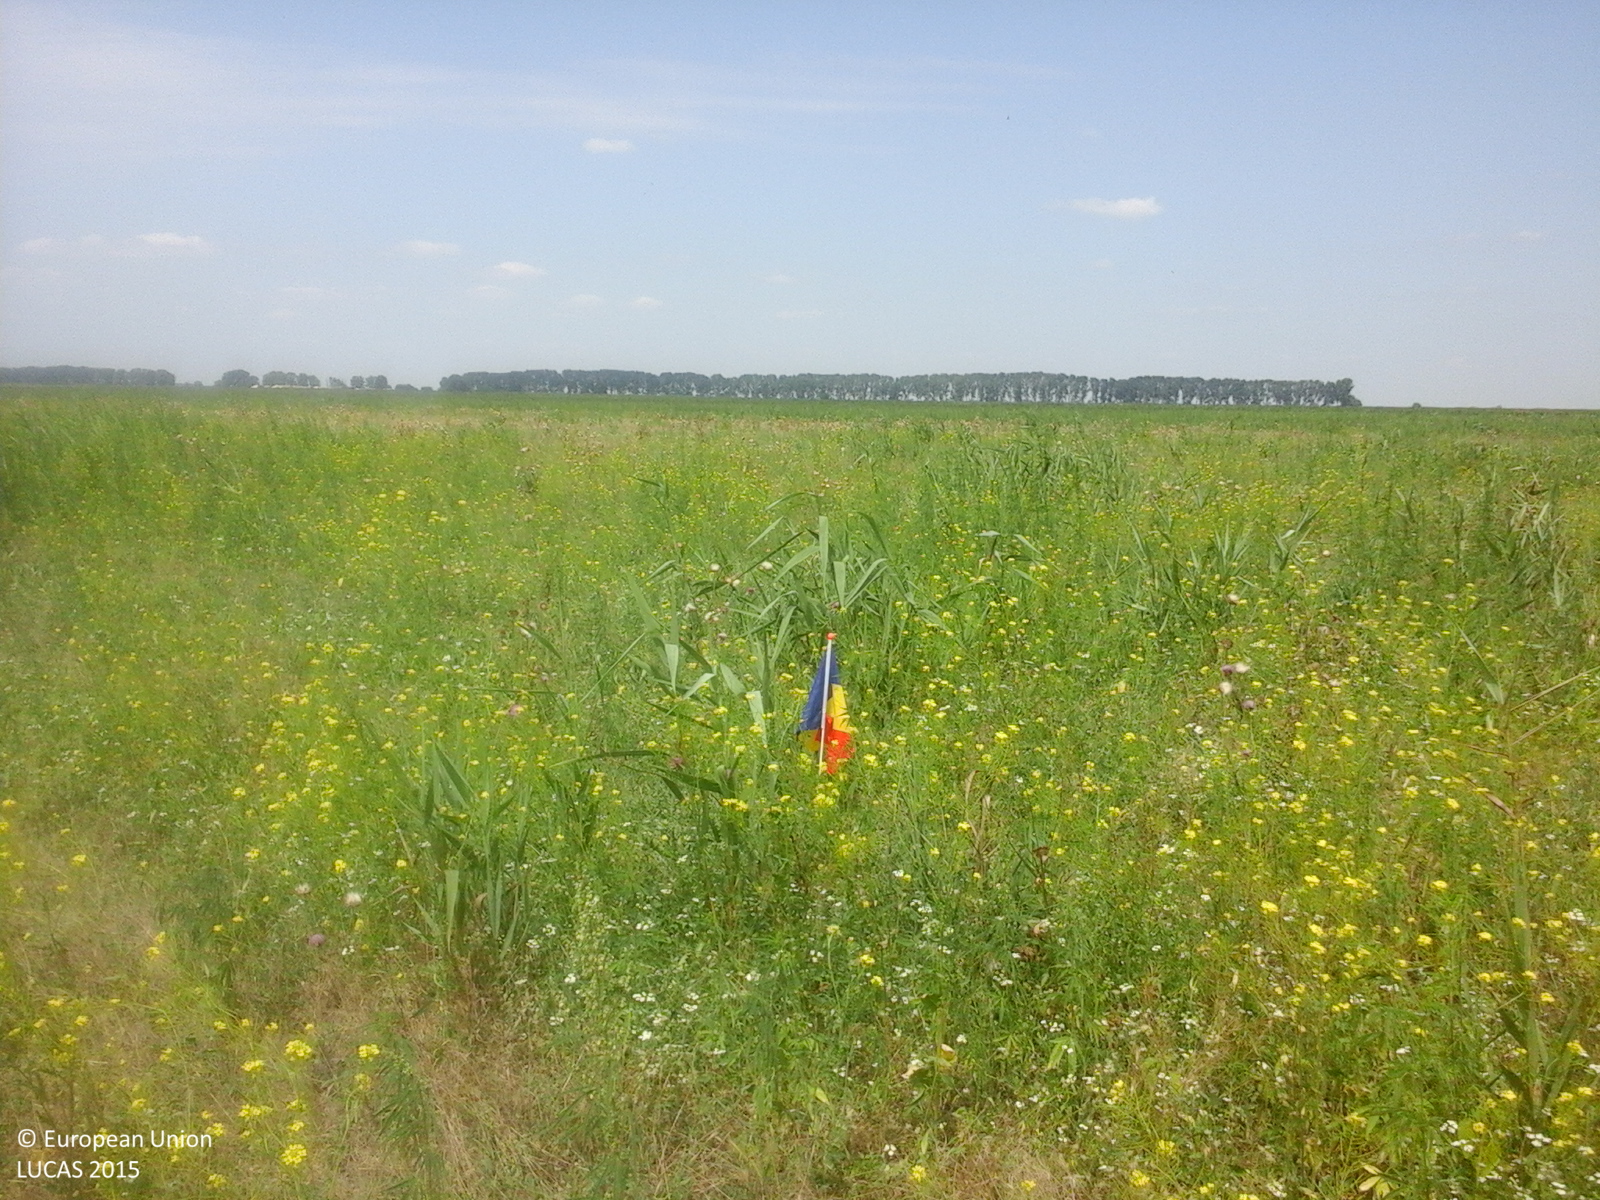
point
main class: Grassland
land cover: Spontaneously vegetated surfaces
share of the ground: > 75 %
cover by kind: herbaceous plants 100 %
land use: Semi-natural and natural areas not in use
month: August
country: RO
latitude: 45.2999
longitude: 29.0634
